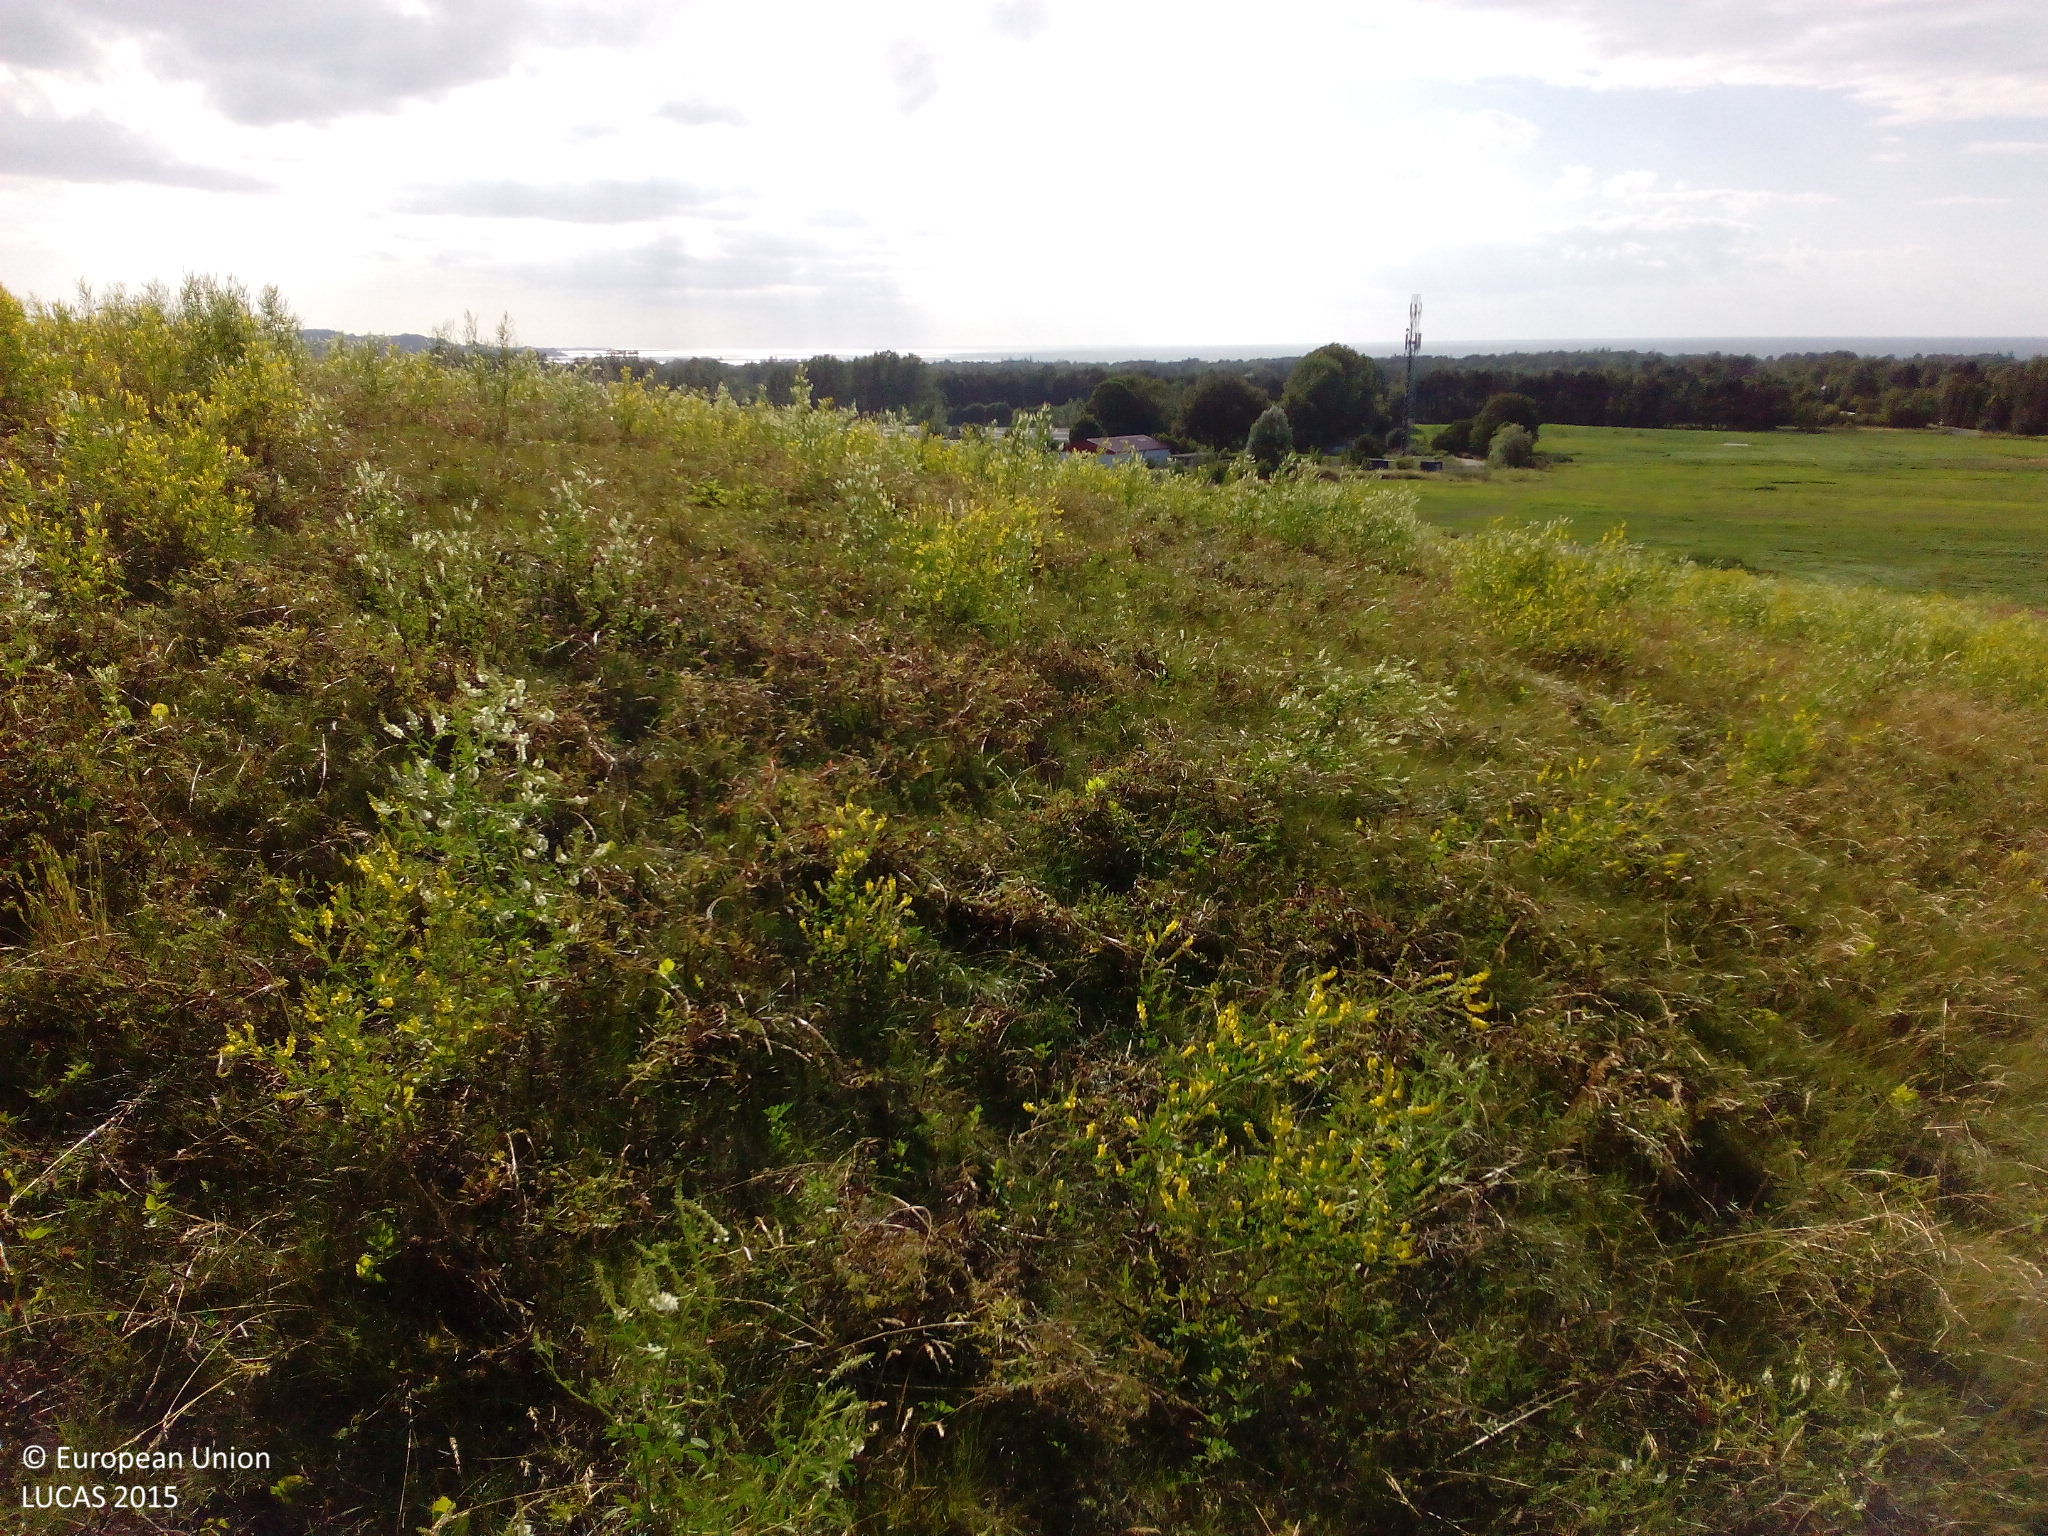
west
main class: Grassland
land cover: Spontaneously vegetated surfaces
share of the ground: > 75 %
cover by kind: herbaceous plants 100 %
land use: Fallow land
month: July
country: DK
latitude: 55.8548
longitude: 11.5480
